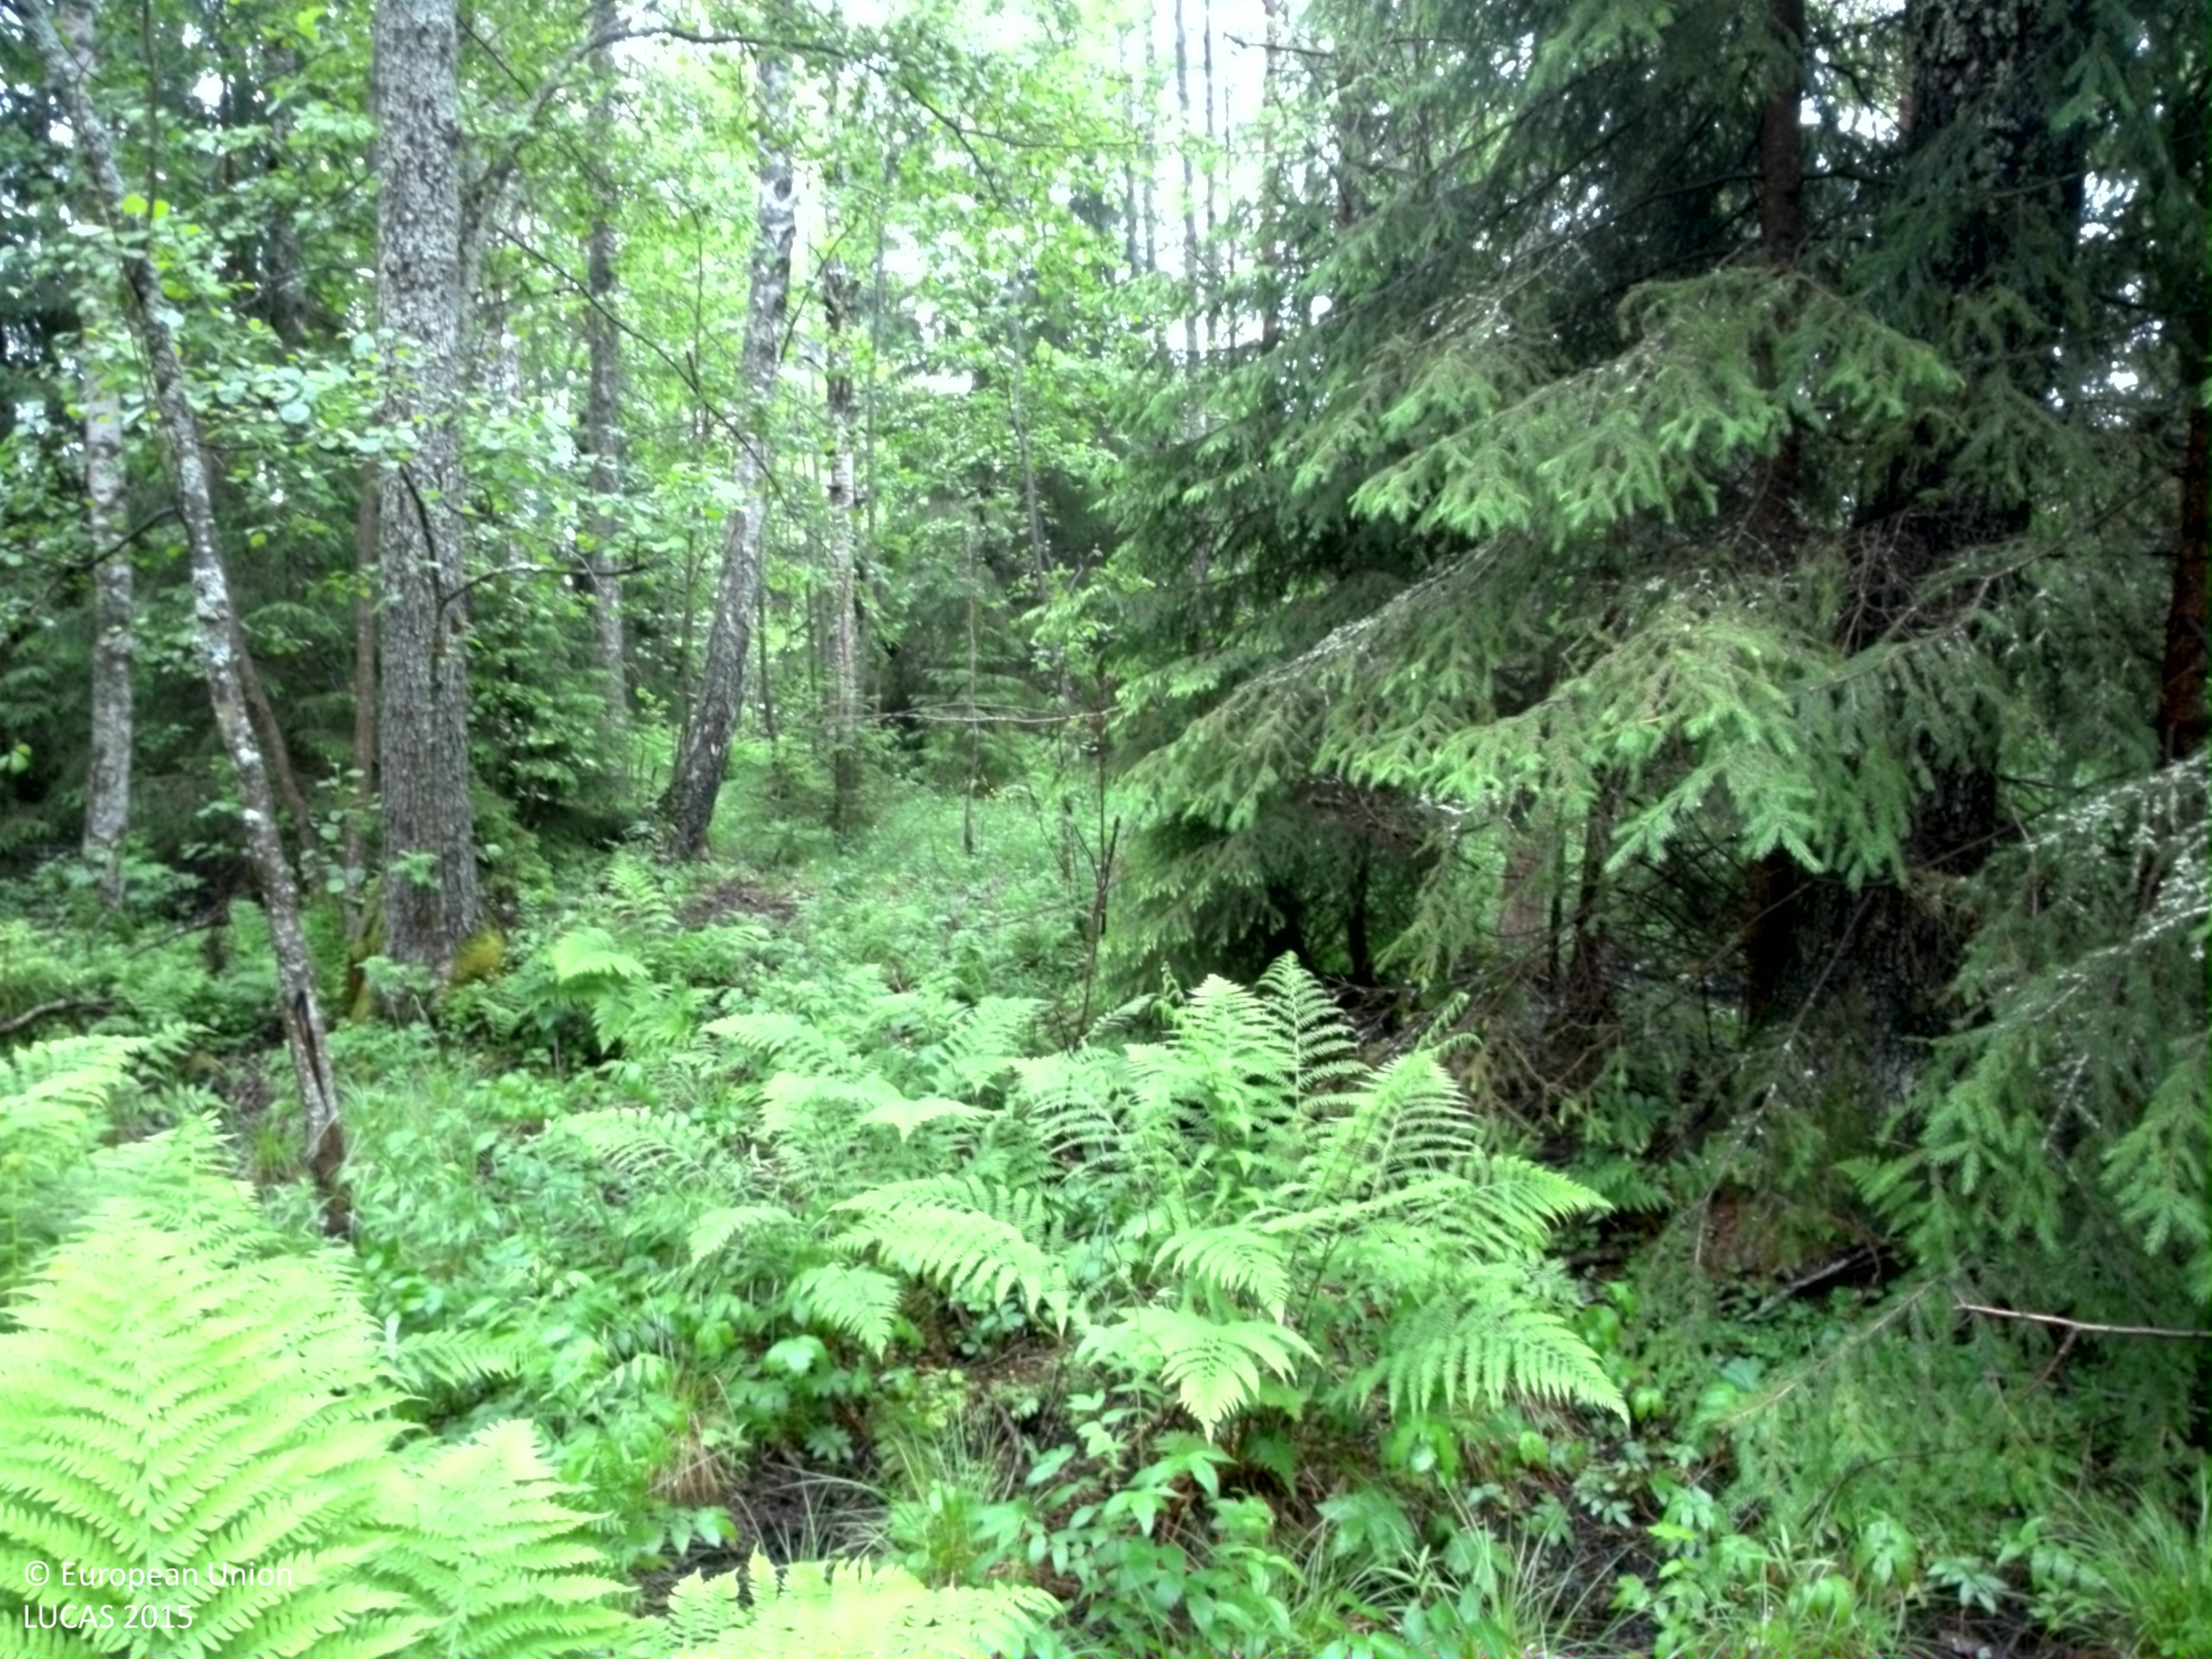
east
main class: Woodland
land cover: Broadleaved woodland
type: boreal forest
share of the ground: 50 - 75 %
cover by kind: broadleaved forest trees 50 %, herbaceous plants 25 %, coniferous forest trees 15 %, shrubs 5 %, lichens and mosses 5 %
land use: Forestry
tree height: > 5 m
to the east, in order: Broadleaved woodland; Spruce dominated mixed woodland
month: June
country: SE
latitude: 60.4000
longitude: 18.1066
